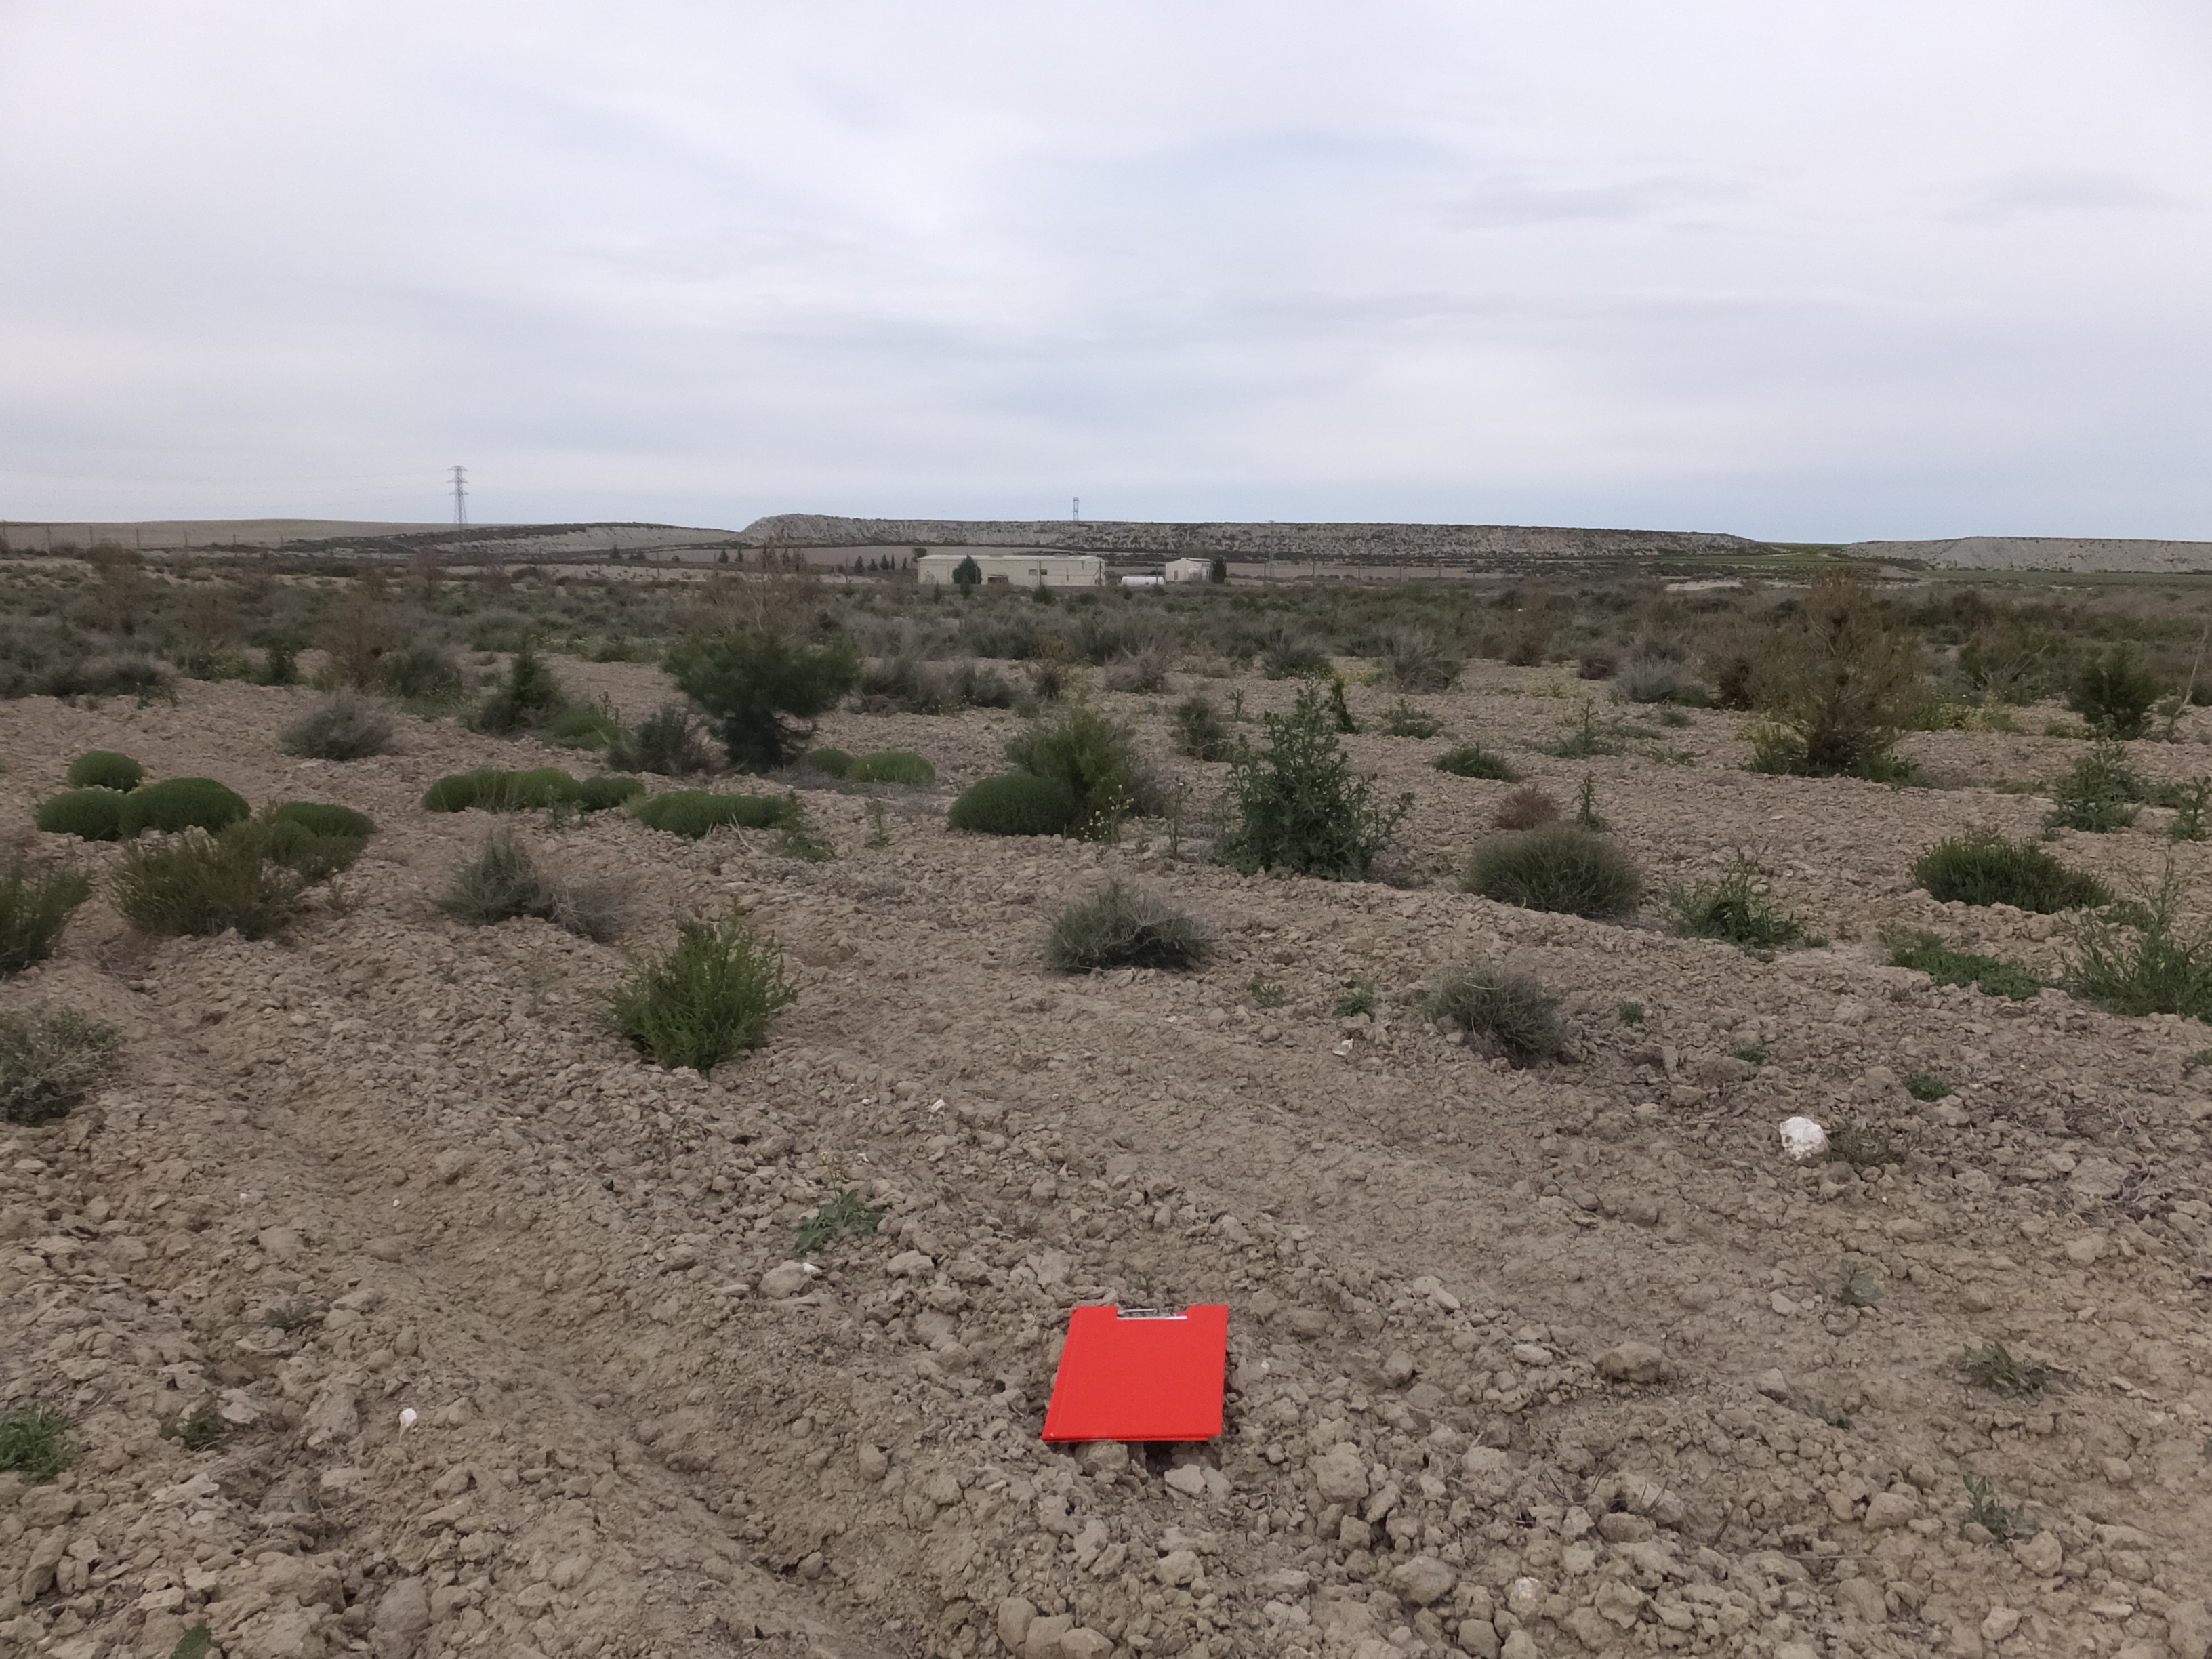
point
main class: Shrubland
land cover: Shrubland with sparse tree cover
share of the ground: 25 - 50 %
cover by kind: unconsolidated bare surface 55 %, shrubs 40 %, coniferous forest trees 5 %
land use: Forestry
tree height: < 5 m
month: April
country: ES
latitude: 41.5406
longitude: -0.1689
